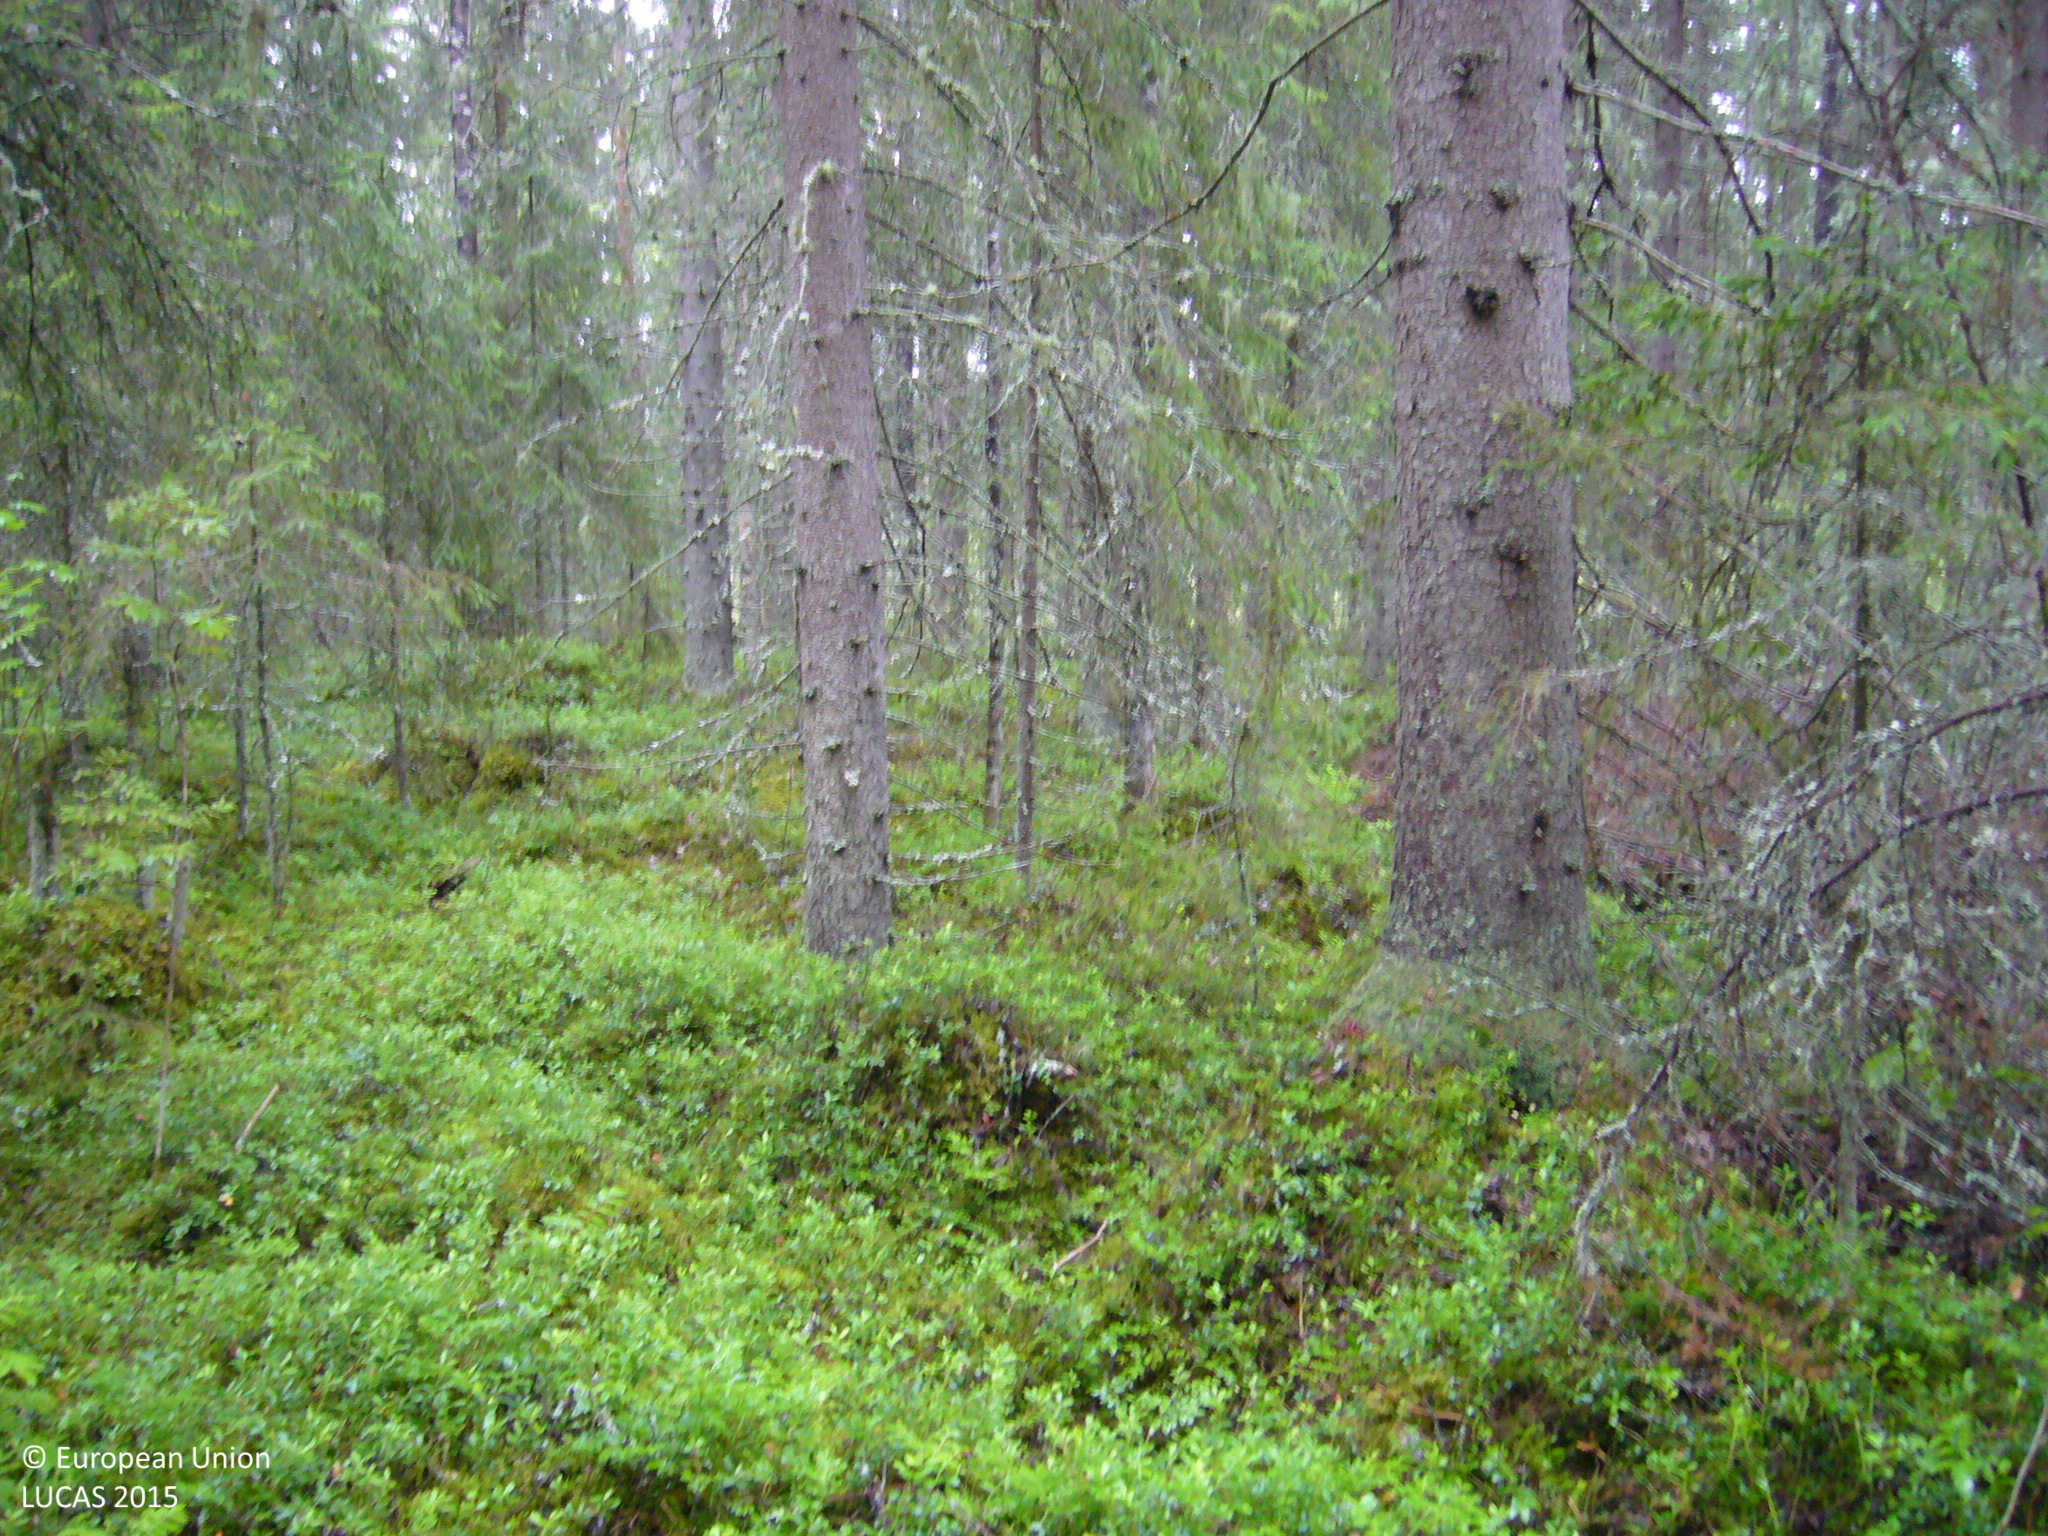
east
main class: Woodland
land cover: Spruce dominated coniferous woodland
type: boreal forest
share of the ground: > 75 %
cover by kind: coniferous forest trees 80 %, shrubs 15 %, broadleaved forest trees 5 %
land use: Forestry
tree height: > 5 m
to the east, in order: Spruce dominated coniferous woodland; Broadleaved woodland; Tracks; Shrubland without tree cover; Electric lines; Shrubland without tree cover; Spruce dominated mixed woodland
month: July
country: FI
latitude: 63.9533
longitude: 25.5910
